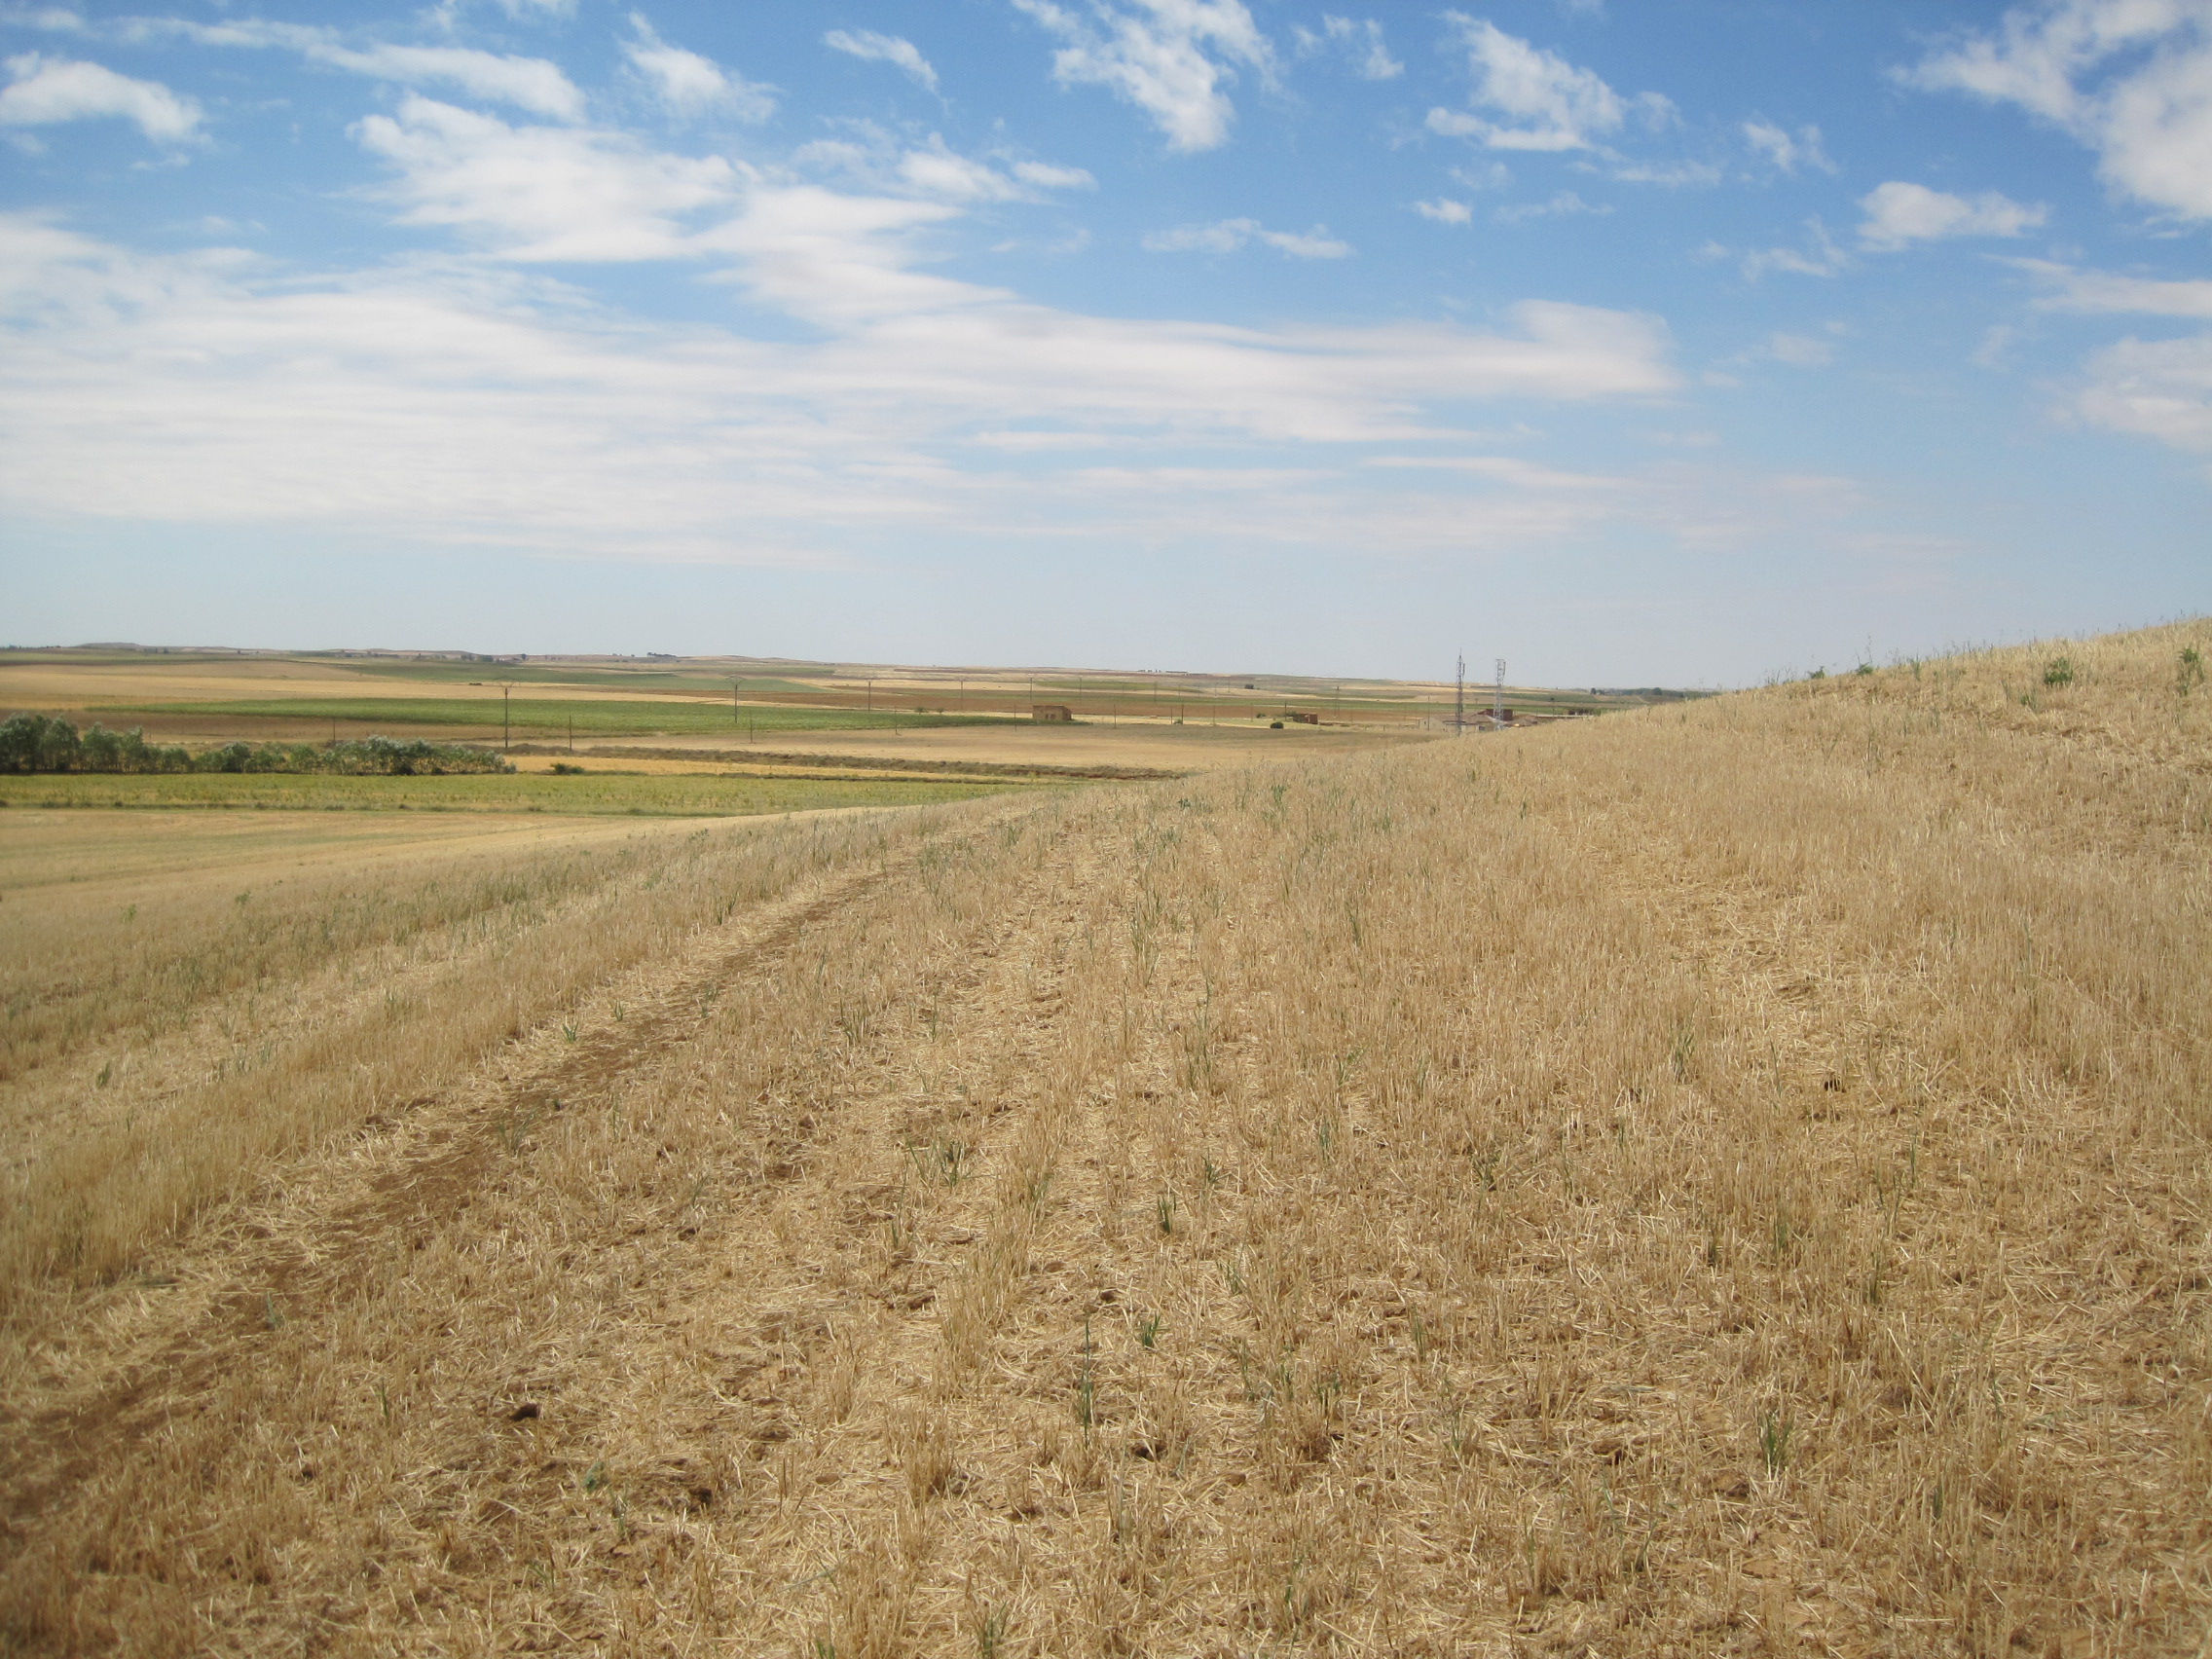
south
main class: Cropland
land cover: Barley
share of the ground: < 10 %
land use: Agriculture (excluding fallow land and kitchen gardens)
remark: Harvested field
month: July
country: ES
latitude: 42.0638
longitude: -5.2259
